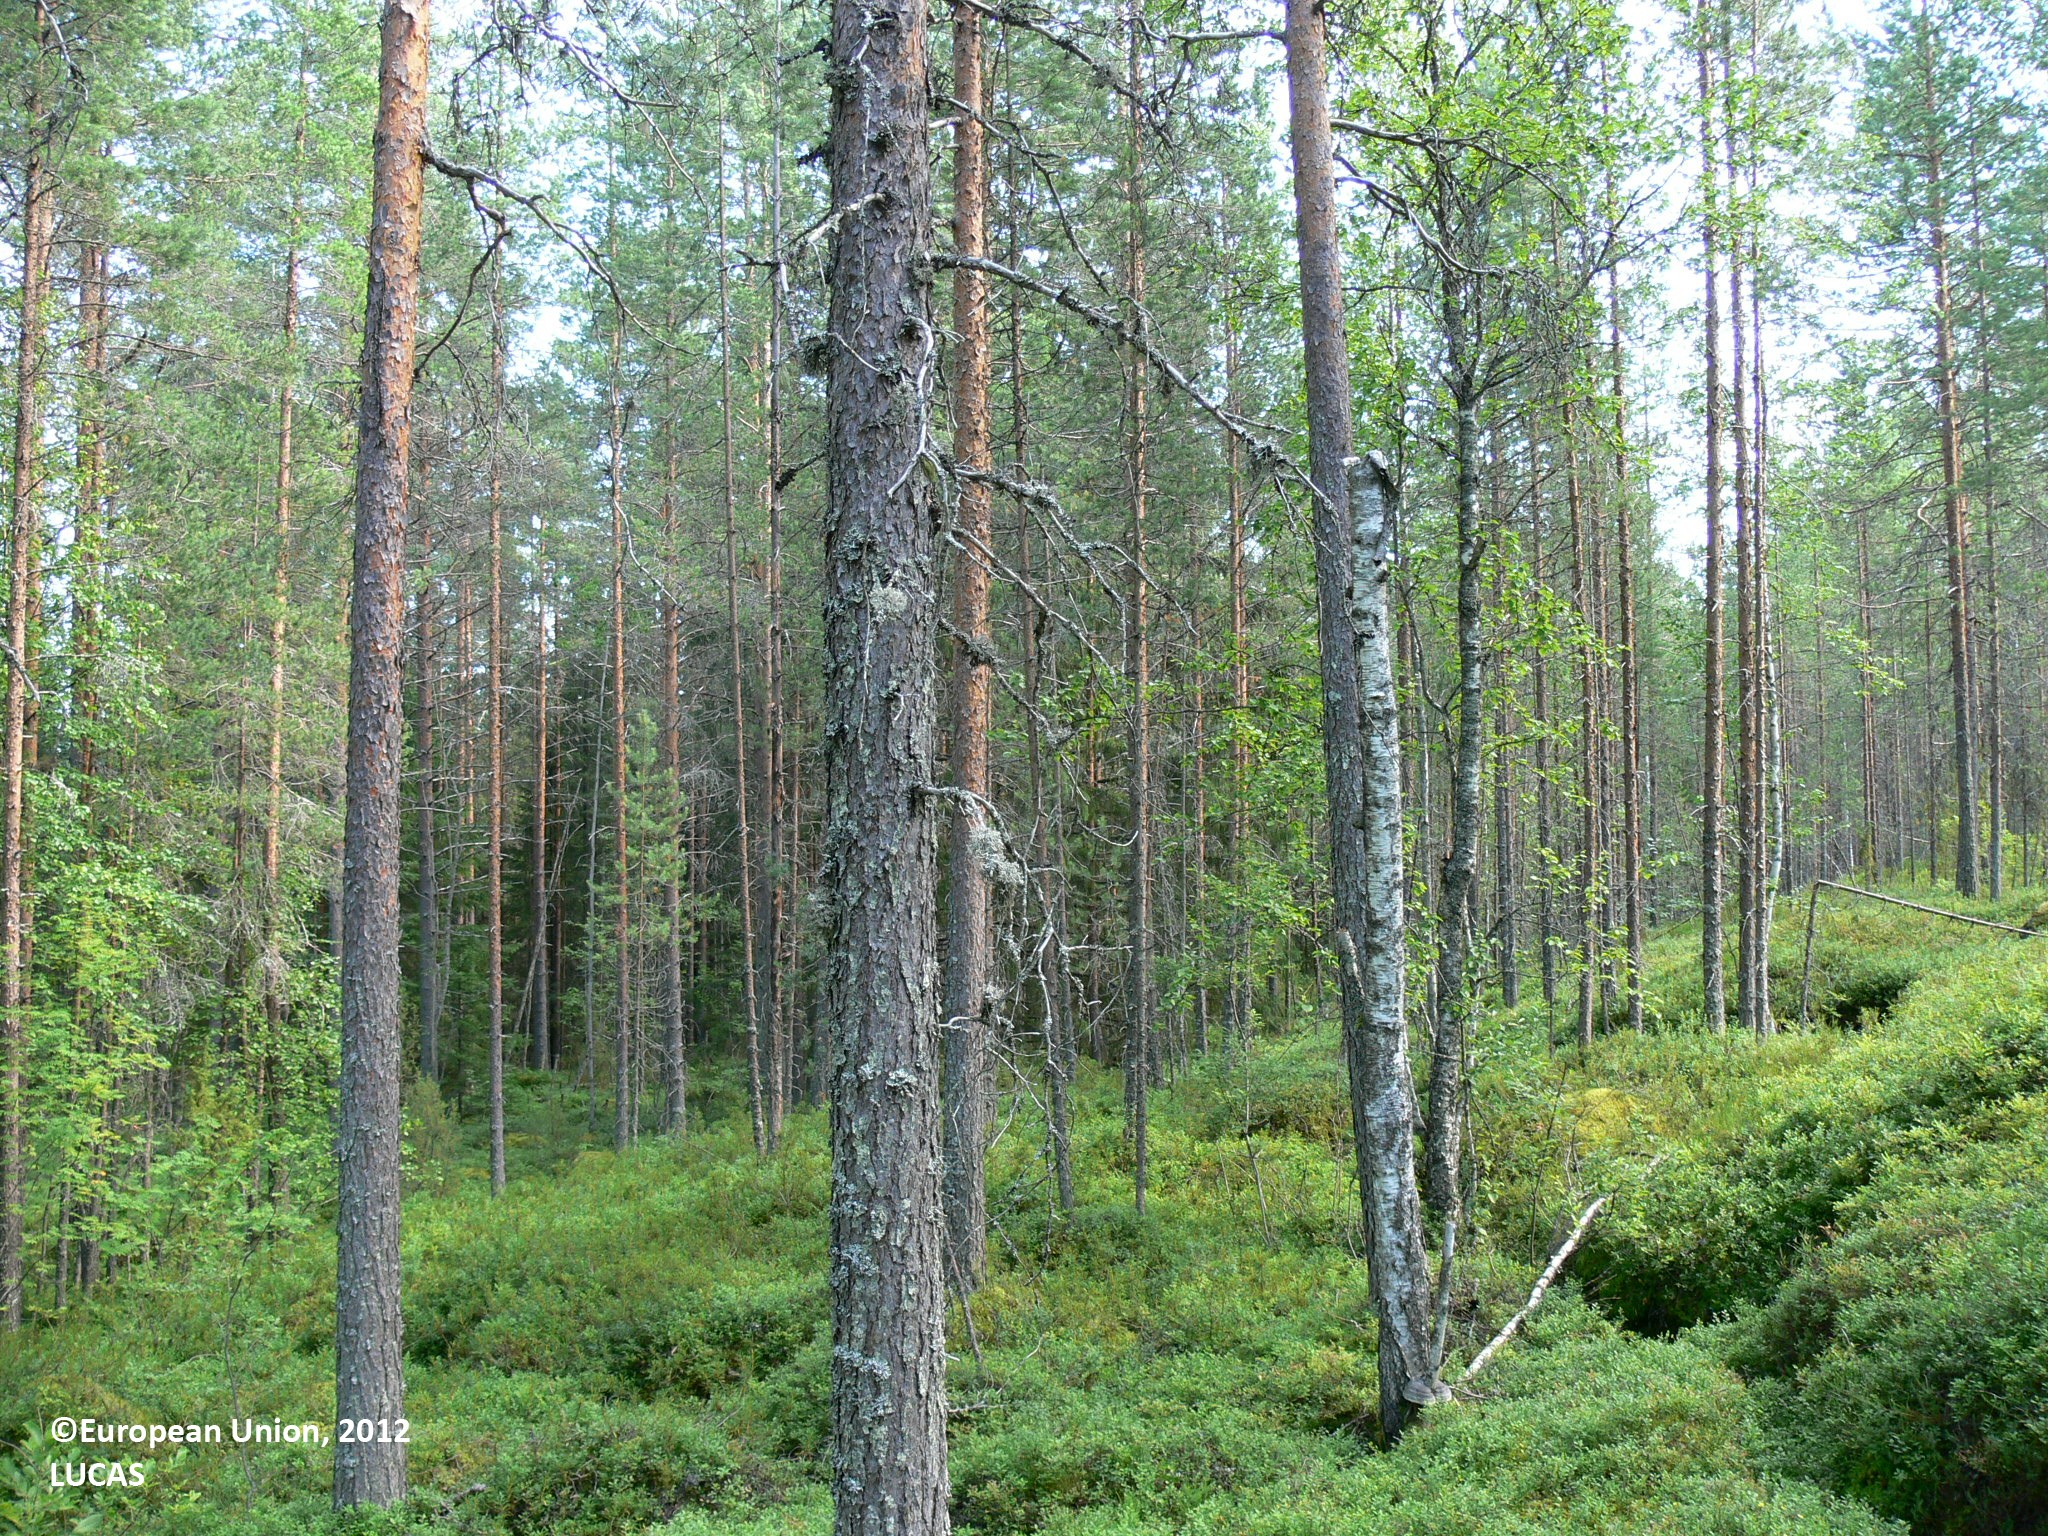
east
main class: Woodland
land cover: Pine dominated coniferous woodland
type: boreal forest
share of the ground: 50 - 75 %
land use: Forestry
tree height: > 5 m
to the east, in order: Pine dominated coniferous woodland; Other coniferous woodland; Spruce dominated coniferous woodland; Other coniferous woodland; Tracks; Other coniferous woodland; Other mixed woodland; Pine dominated coniferous woodland
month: July
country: FI
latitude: 63.2866
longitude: 29.3040
